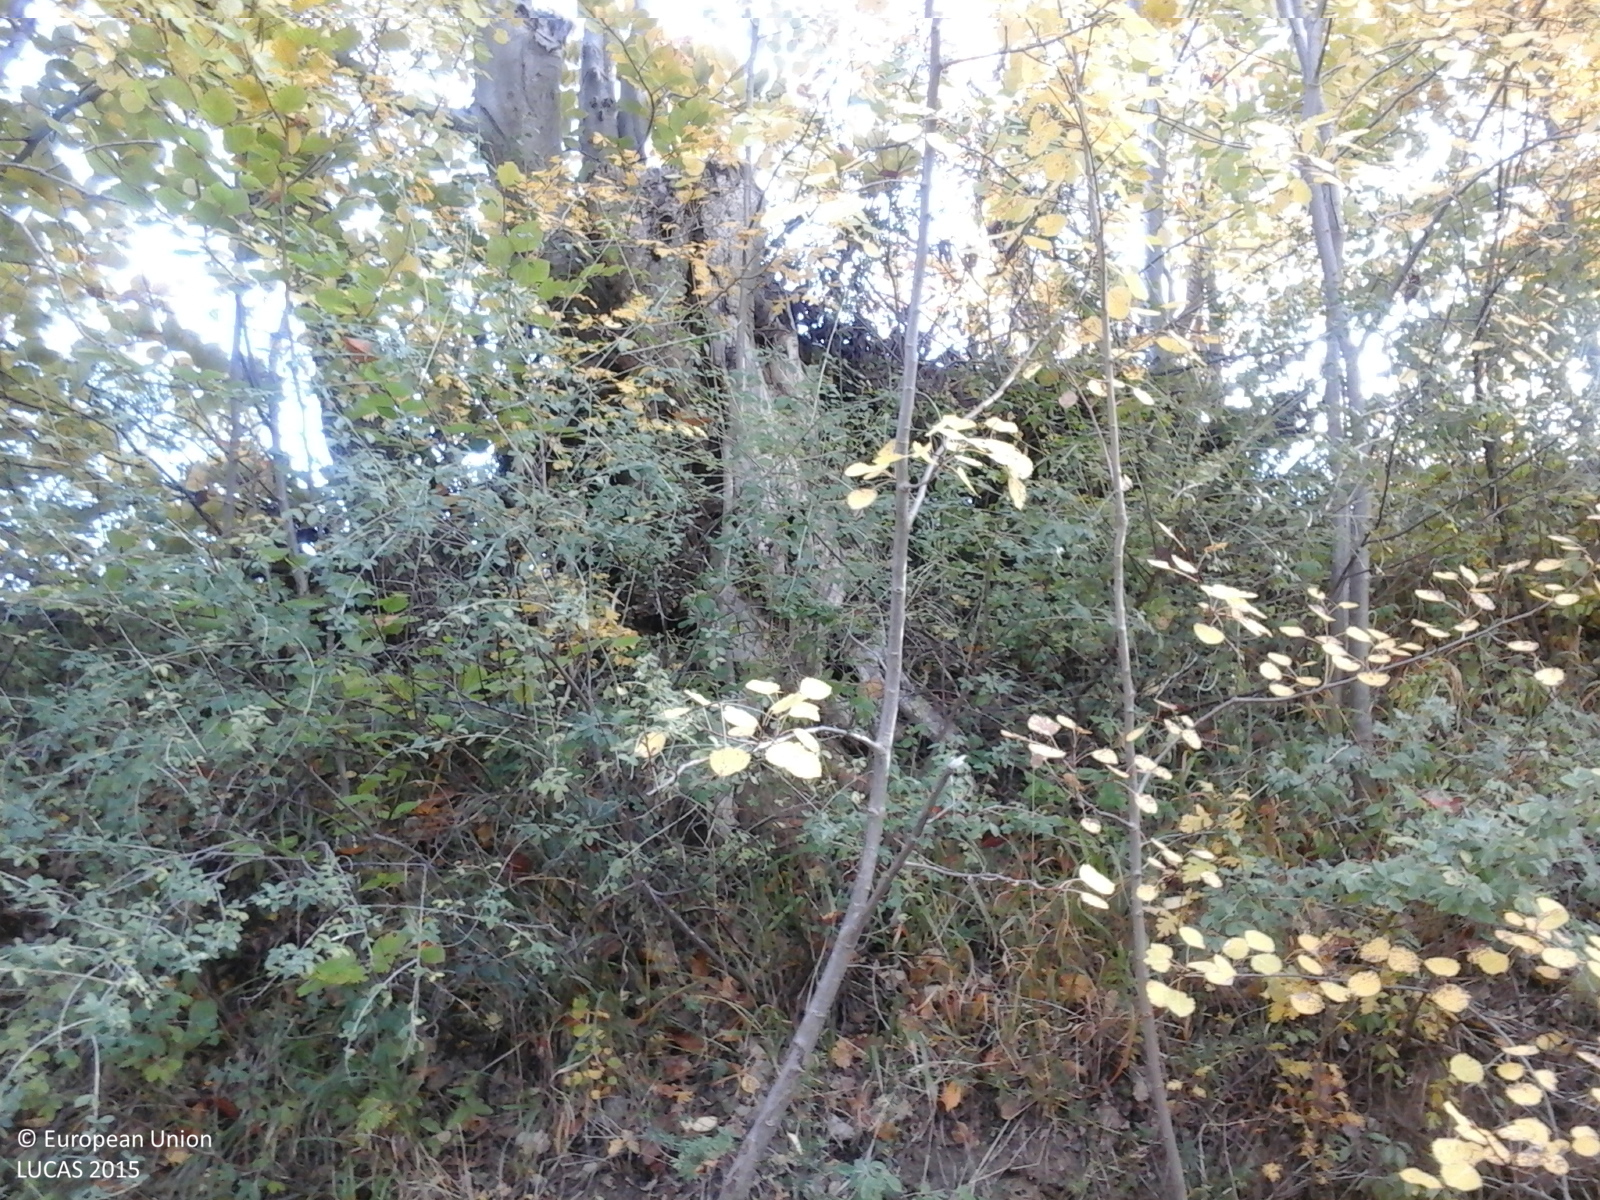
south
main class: Woodland
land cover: Broadleaved woodland
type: beech forest
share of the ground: > 75 %
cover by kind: broadleaved forest trees 100 %
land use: Forestry
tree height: > 5 m
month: October
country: RO
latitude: 45.6058
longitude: 26.8687
